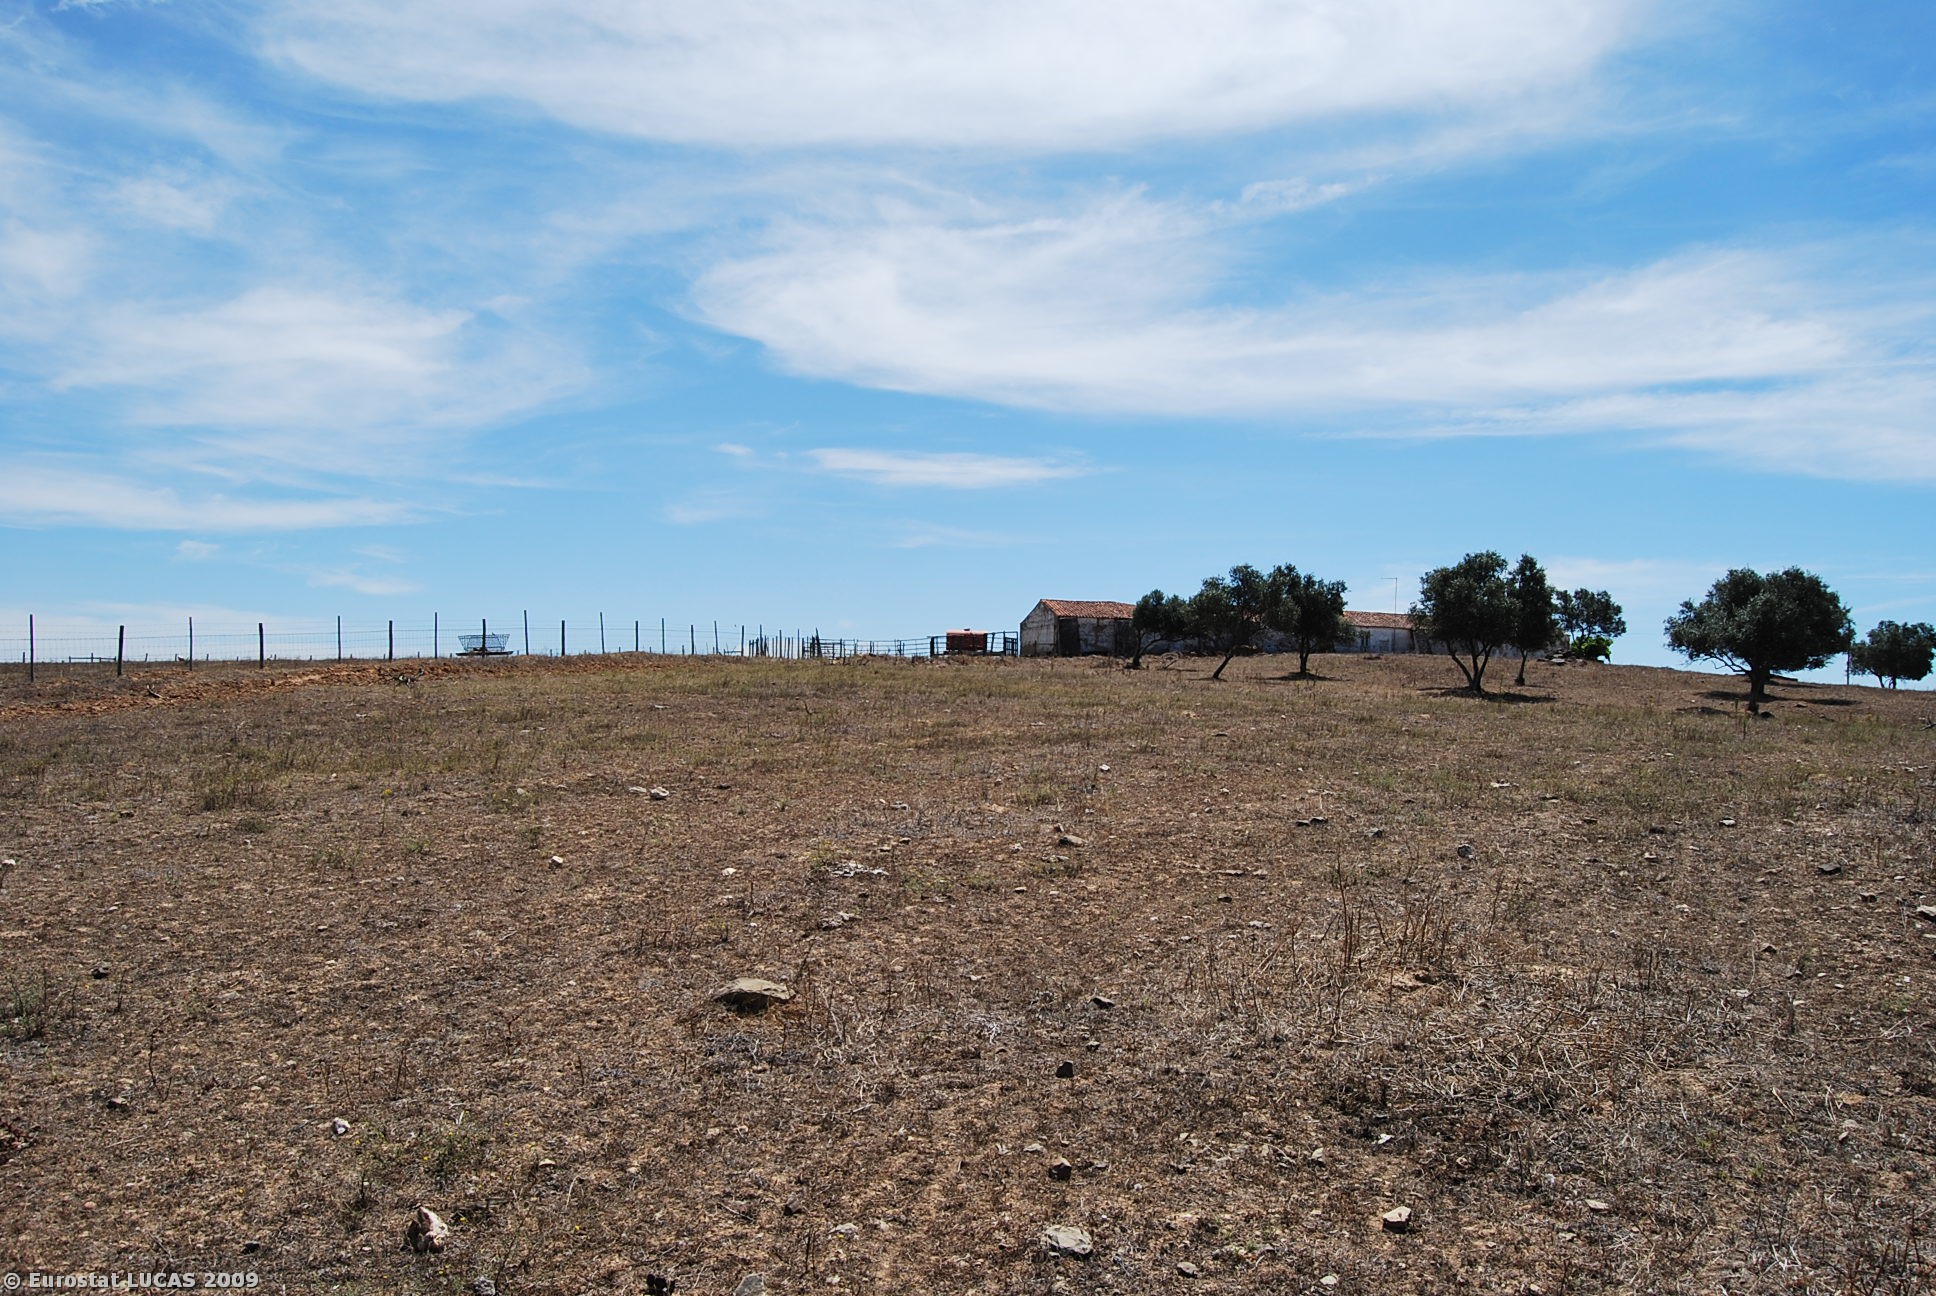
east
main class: Grassland
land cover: Grassland without tree/shrub cover
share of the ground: > 75 %
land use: Agriculture (excluding fallow land and kitchen gardens)
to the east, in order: Grassland without tree/shrub cover; Fences; Spontaneously vegetated surfaces; Artificial constructions in urban areas; Bare land; Fences; Grassland without tree/shrub cover; Fences; Grassland without tree/shrub cover; Broadleaved woodland
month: July
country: PT
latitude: 37.6829
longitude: -8.2756
